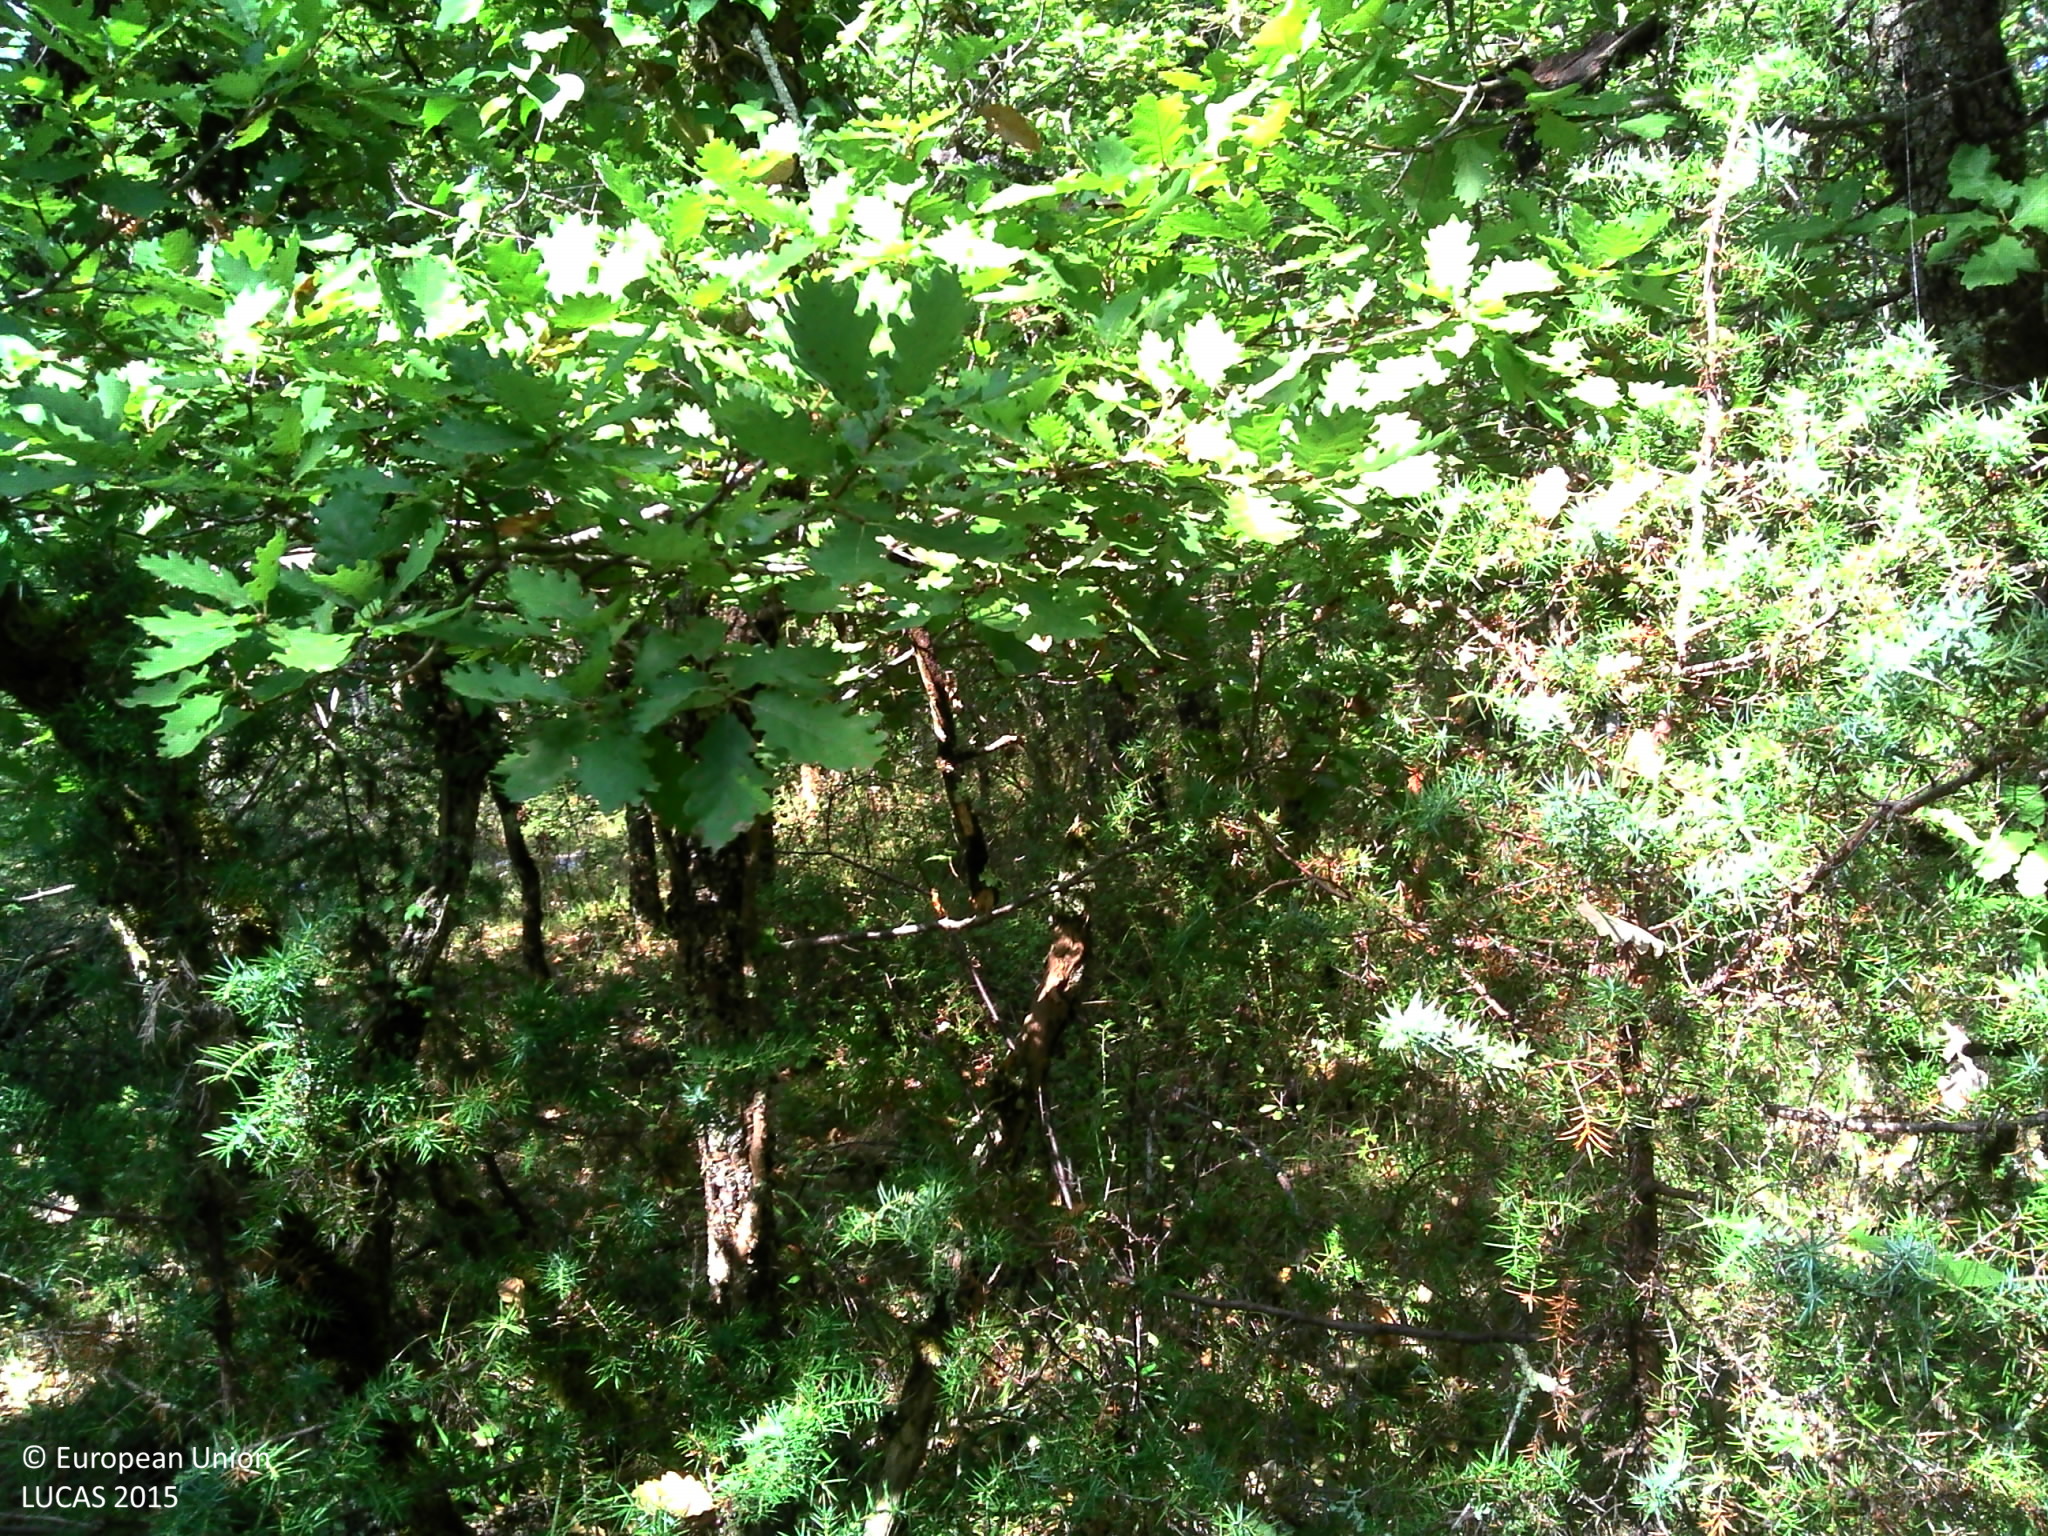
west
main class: Woodland
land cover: Broadleaved woodland
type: mesophytic deciduous forest
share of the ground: > 75 %
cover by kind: broadleaved forest trees 90 %, coniferous forest trees 10 %
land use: Agriculture (excluding fallow land and kitchen gardens)
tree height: > 5 m
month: August
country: FR
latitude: 44.2490
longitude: 1.6471
